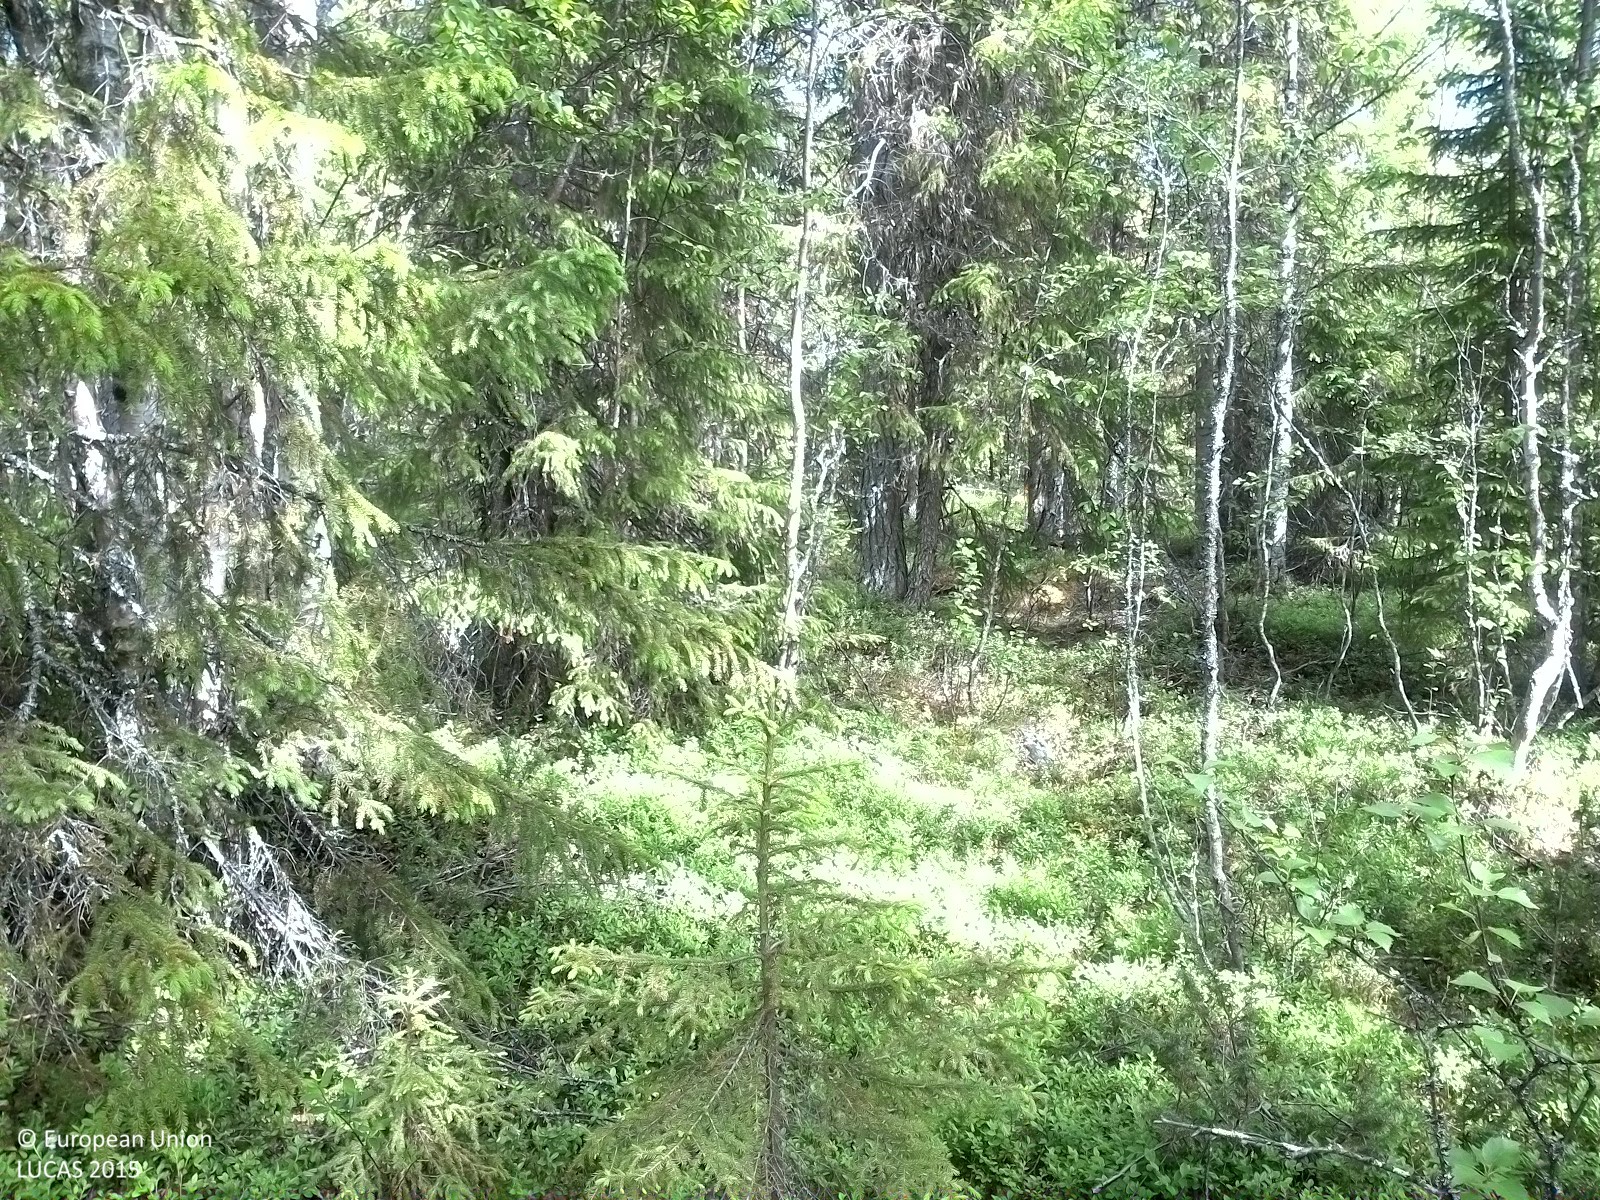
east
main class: Woodland
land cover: Spruce dominated mixed woodland
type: boreal forest
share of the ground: > 75 %
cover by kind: coniferous forest trees 65 %, broadleaved forest trees 25 %, shrubs 10 %
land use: Forestry
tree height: > 5 m
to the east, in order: Spruce dominated mixed woodland
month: June
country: SE
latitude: 63.5314
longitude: 15.3046
